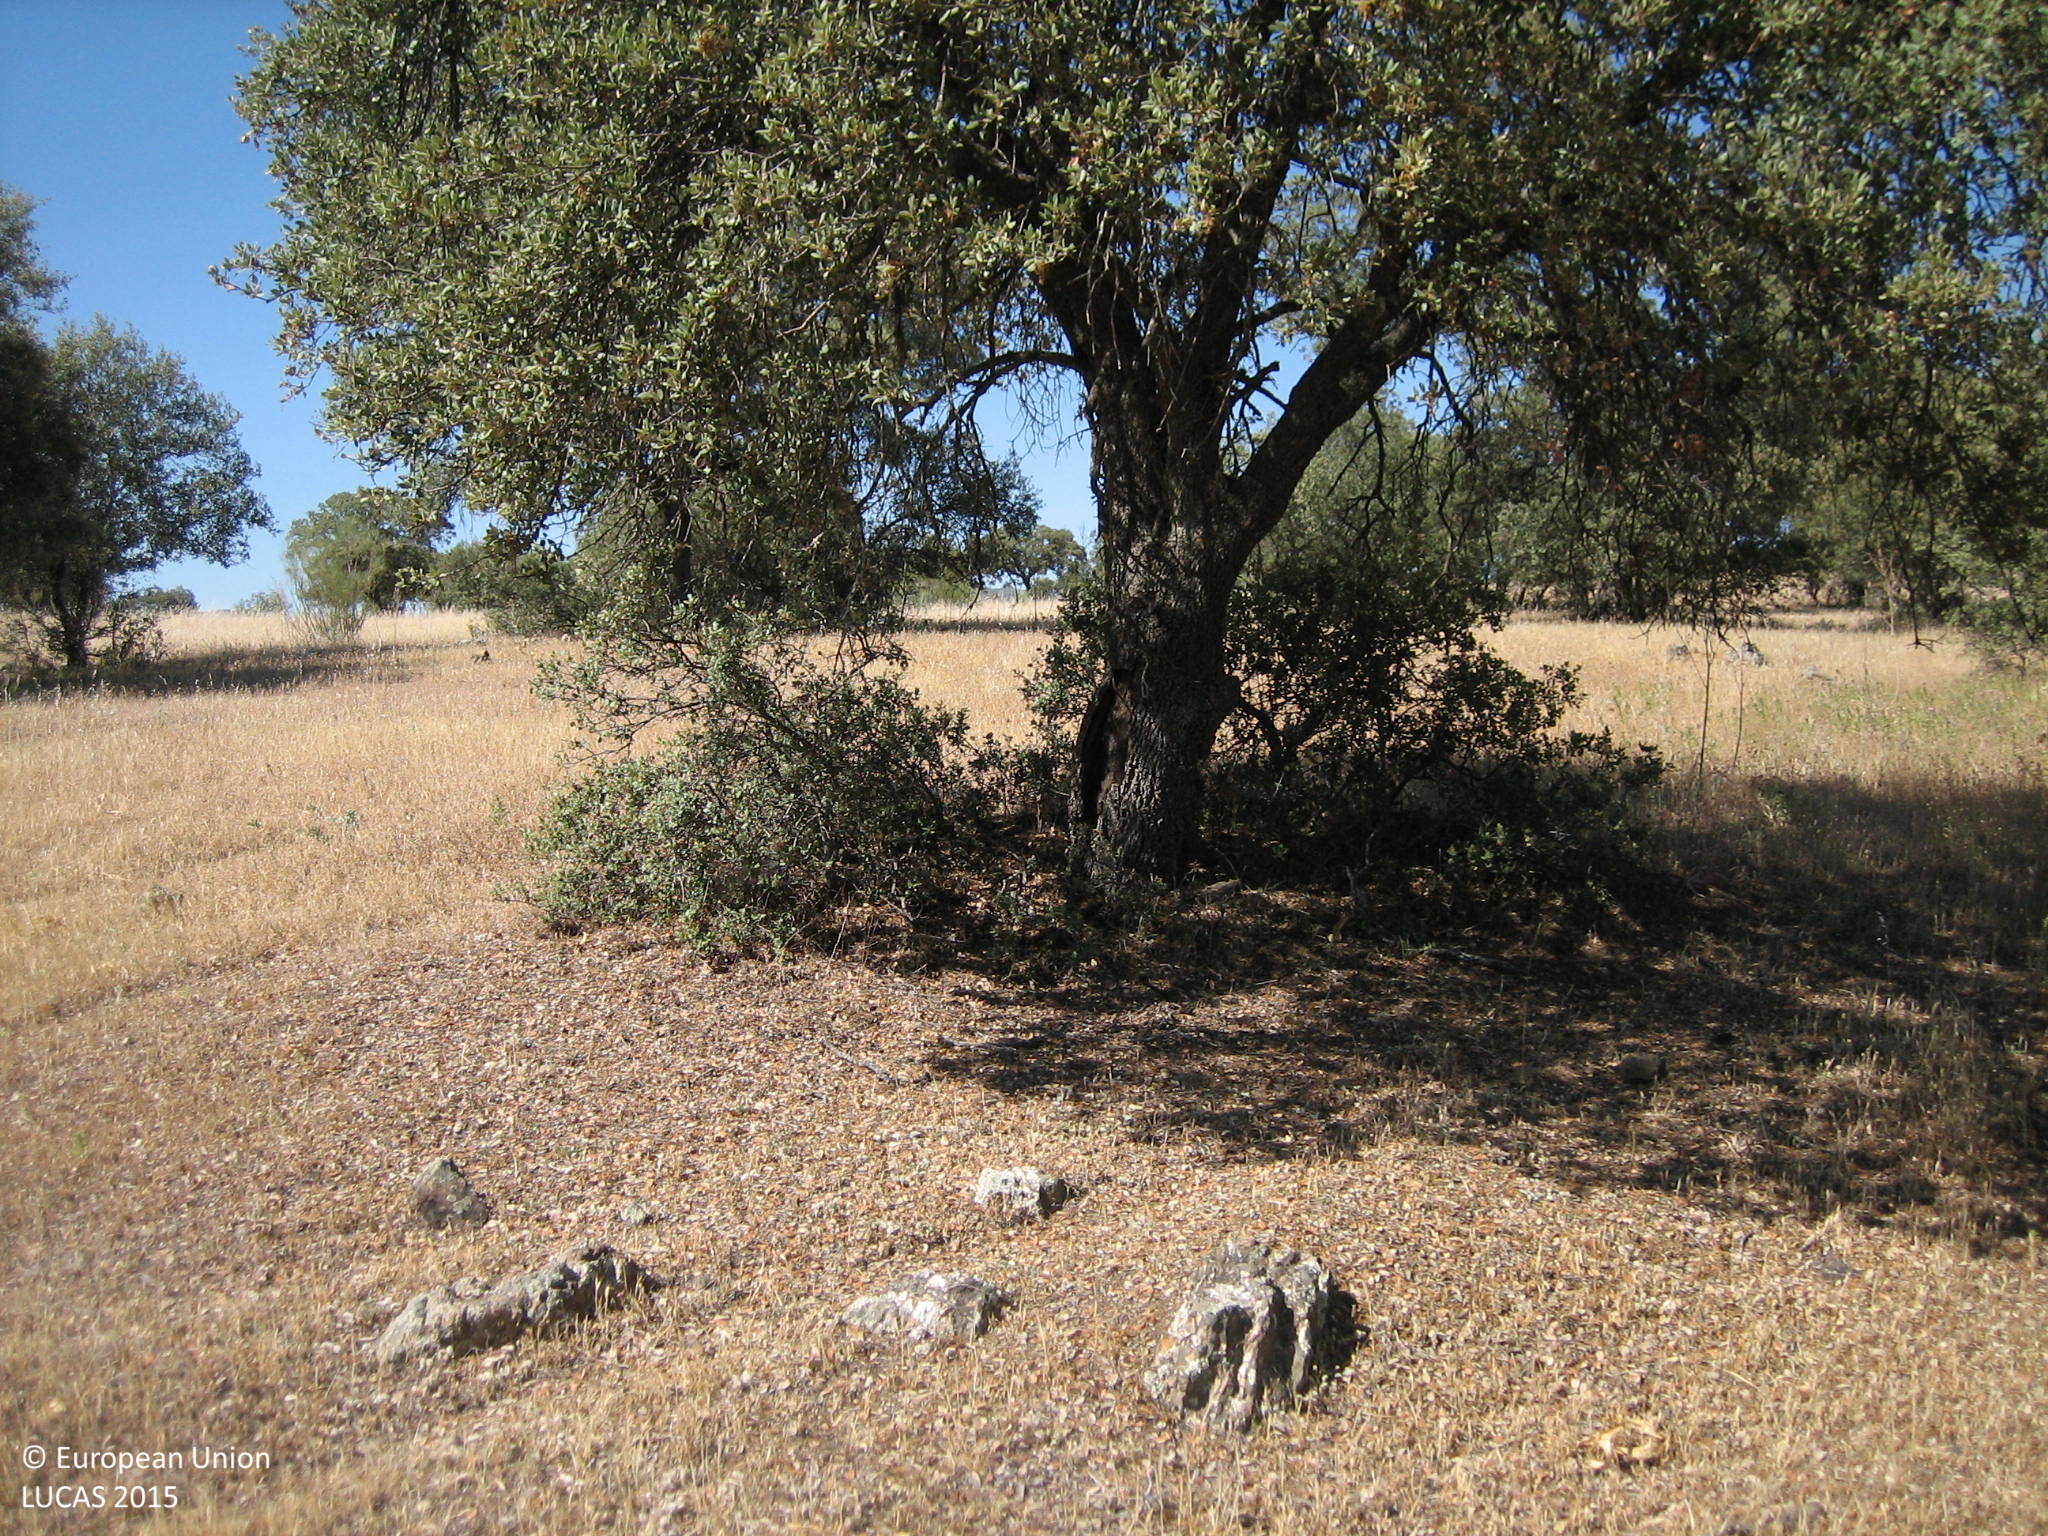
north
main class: Woodland
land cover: Broadleaved woodland
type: broadleaved evergreen forest
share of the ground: 10 - 25 %
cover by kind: herbaceous plants 85 %, broadleaved forest trees 15 %
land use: Forestry
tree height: > 5 m
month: May
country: ES
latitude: 38.5103
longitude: -3.9705
